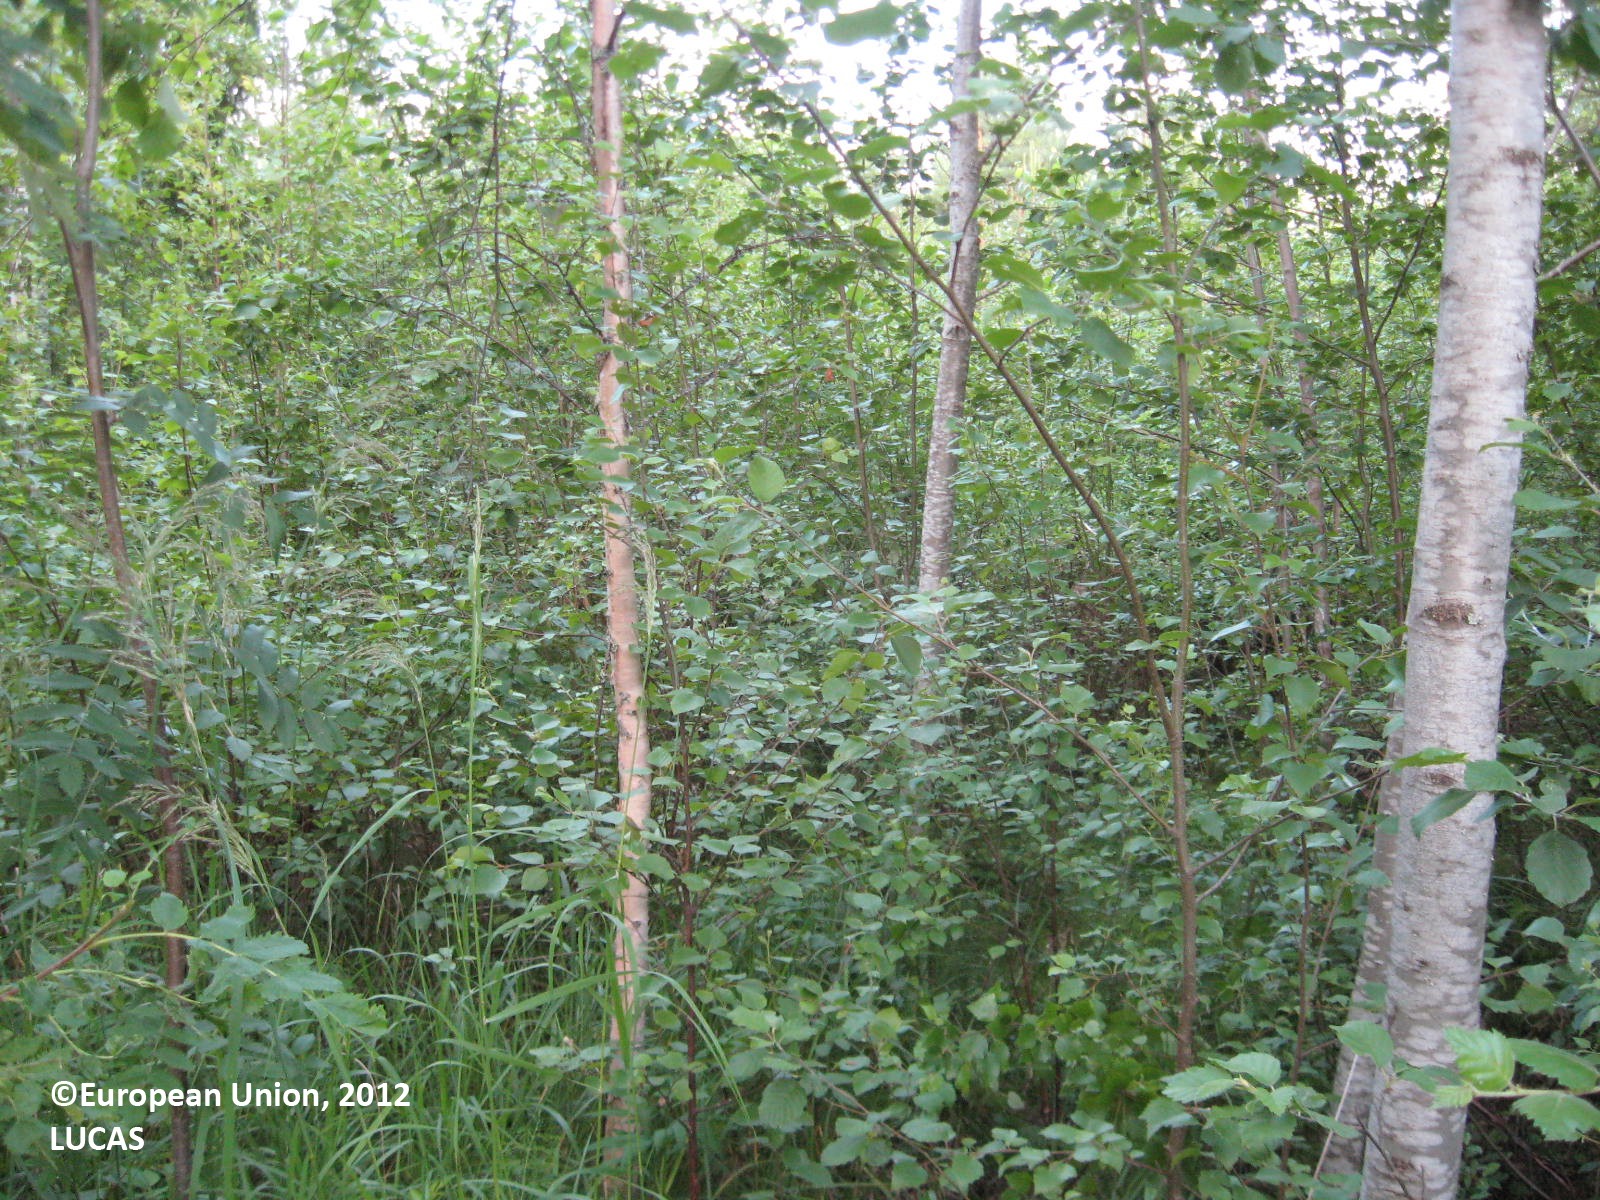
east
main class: Woodland
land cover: Broadleaved woodland
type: boreal forest
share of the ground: > 75 %
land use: Forestry
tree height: > 5 m
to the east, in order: Broadleaved woodland; Other mixed woodland; Ditches and canals; Other mixed woodland
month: July
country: FI
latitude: 62.4888
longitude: 21.6298
